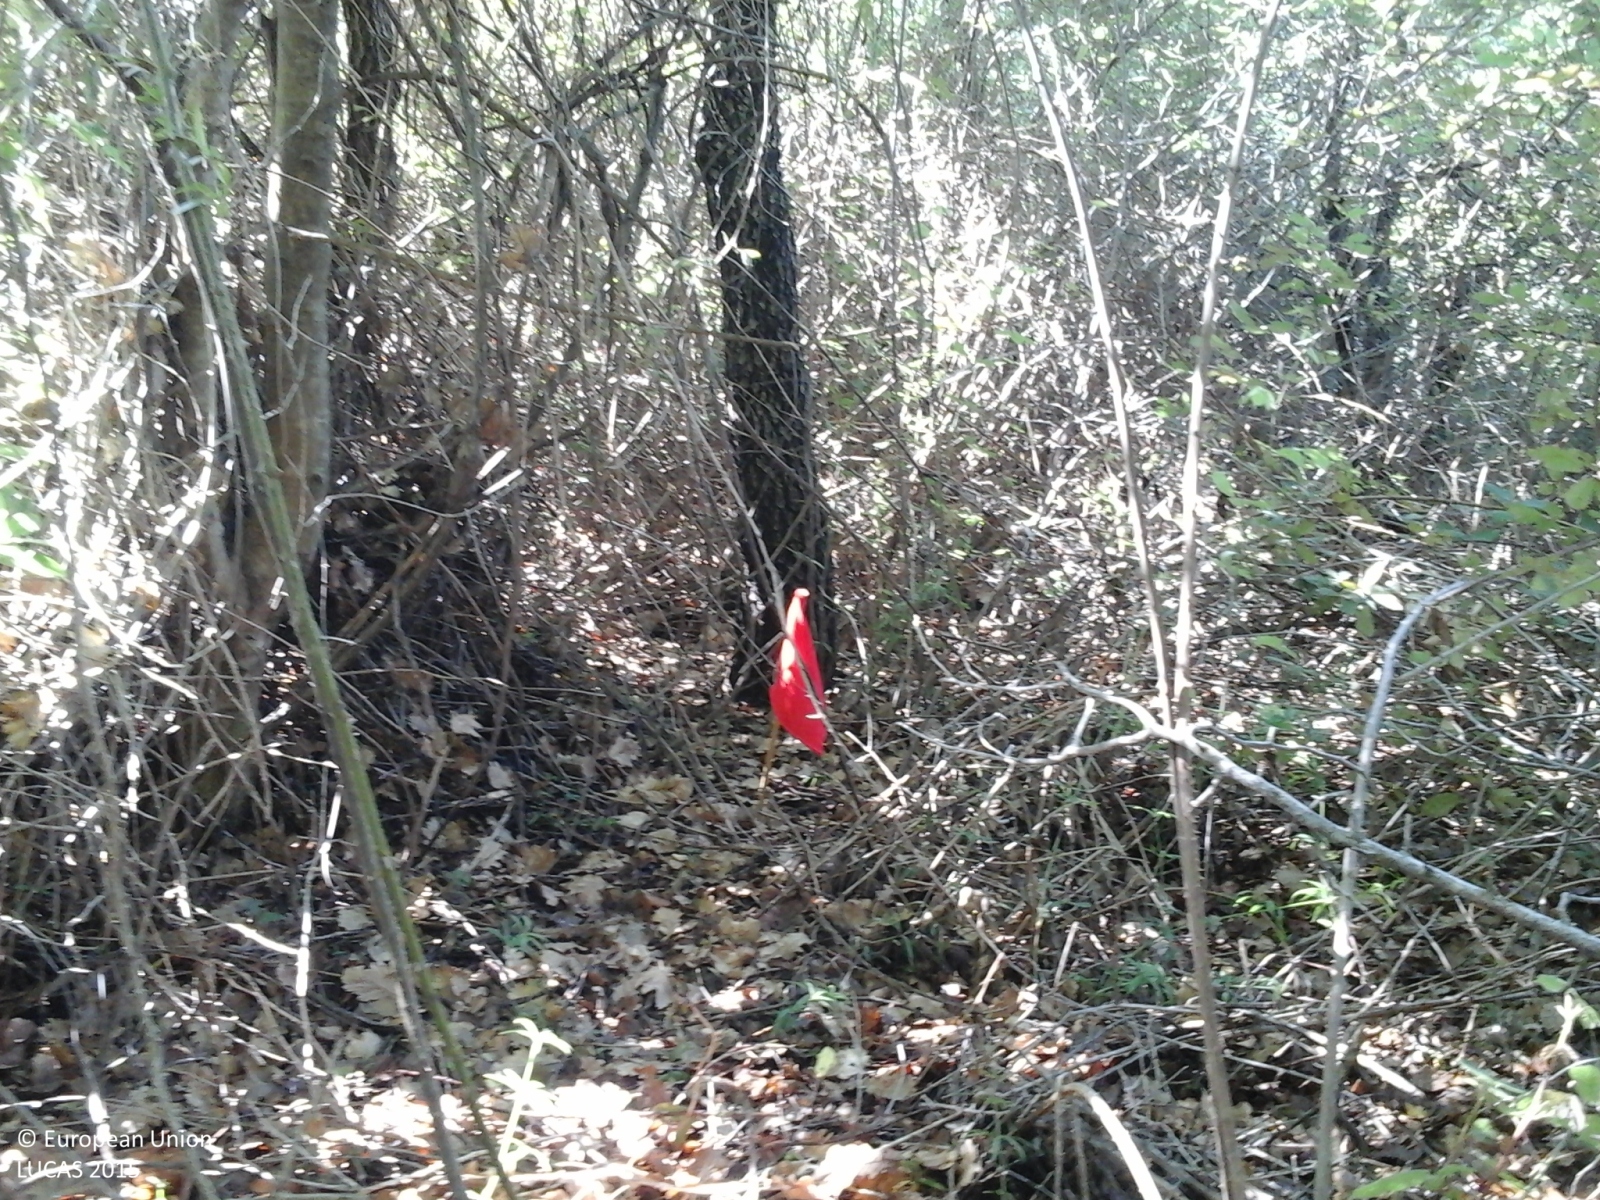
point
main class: Woodland
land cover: Broadleaved woodland
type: thermophilous deciduous forest
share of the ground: > 75 %
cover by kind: broadleaved forest trees 90 %, shrubs 5 %, herbaceous plants 5 %
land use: Forestry
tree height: < 5 m
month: May
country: IT
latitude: 37.9879
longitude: 14.0594
